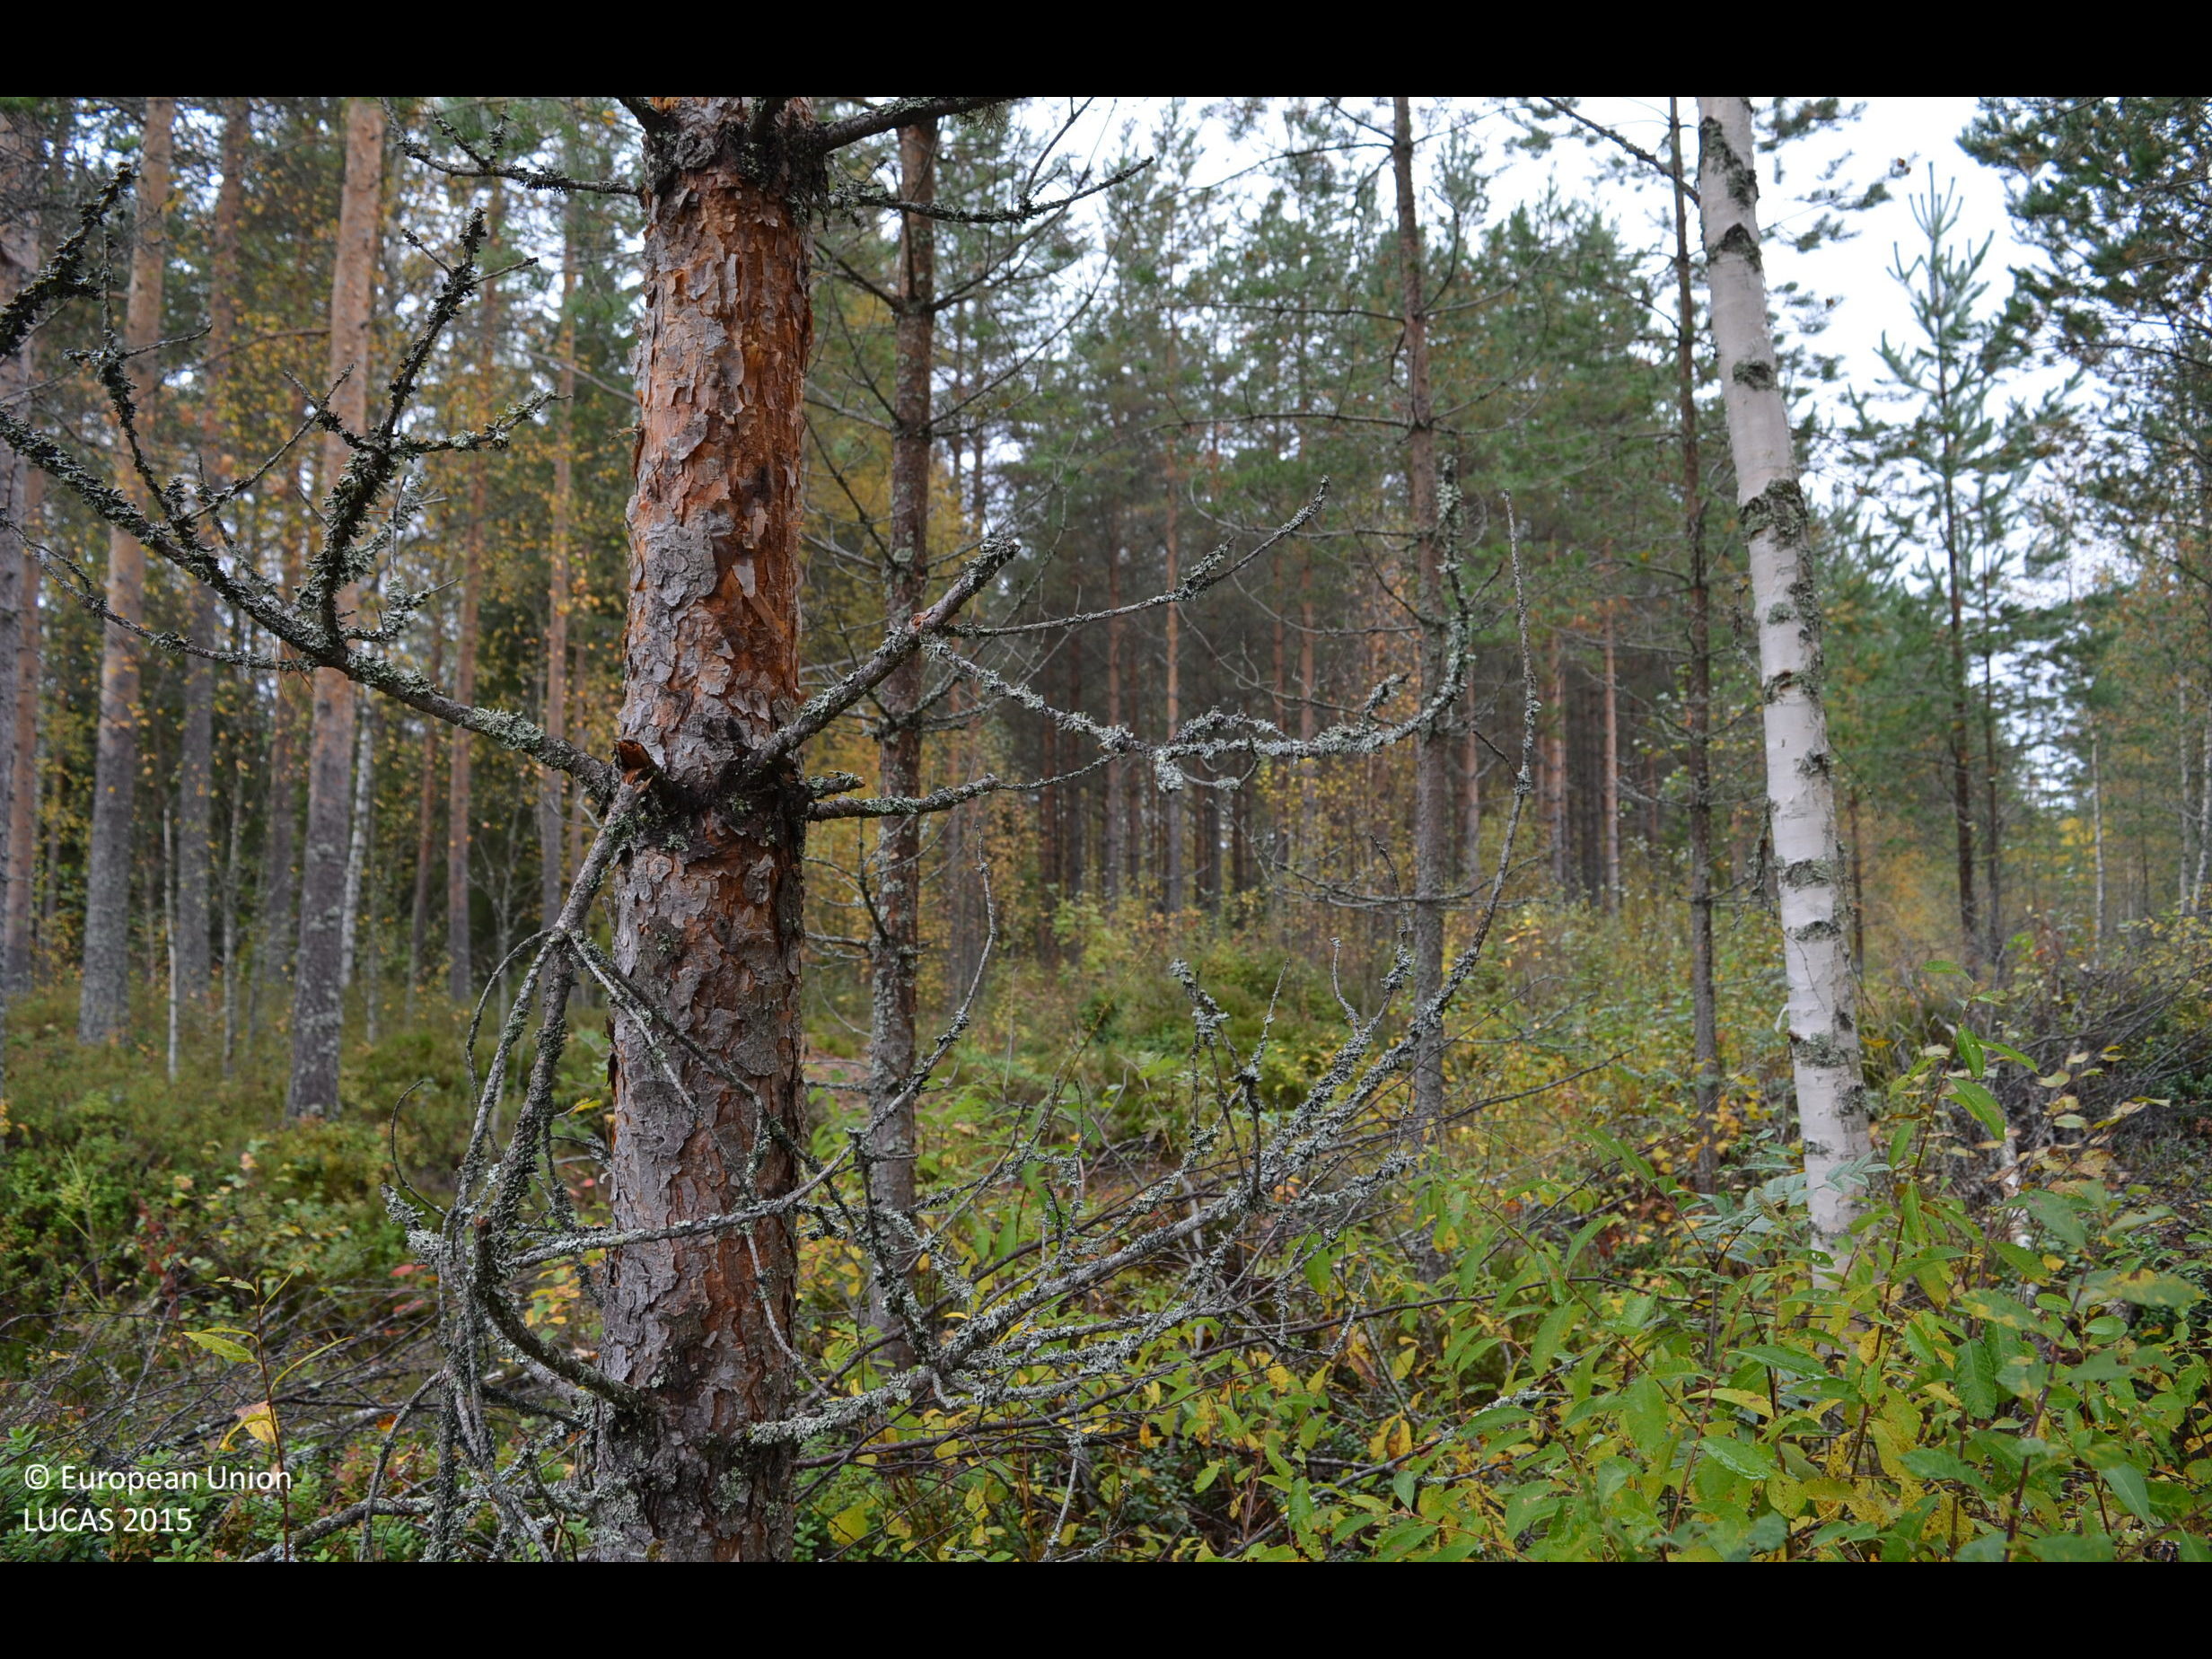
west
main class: Woodland
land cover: Pine dominated coniferous woodland
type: boreal forest
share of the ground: > 75 %
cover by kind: coniferous forest trees 75 %, shrubs 20 %, broadleaved forest trees 5 %
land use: Forestry
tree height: > 5 m
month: September
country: FI
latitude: 62.6564
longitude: 23.7539
